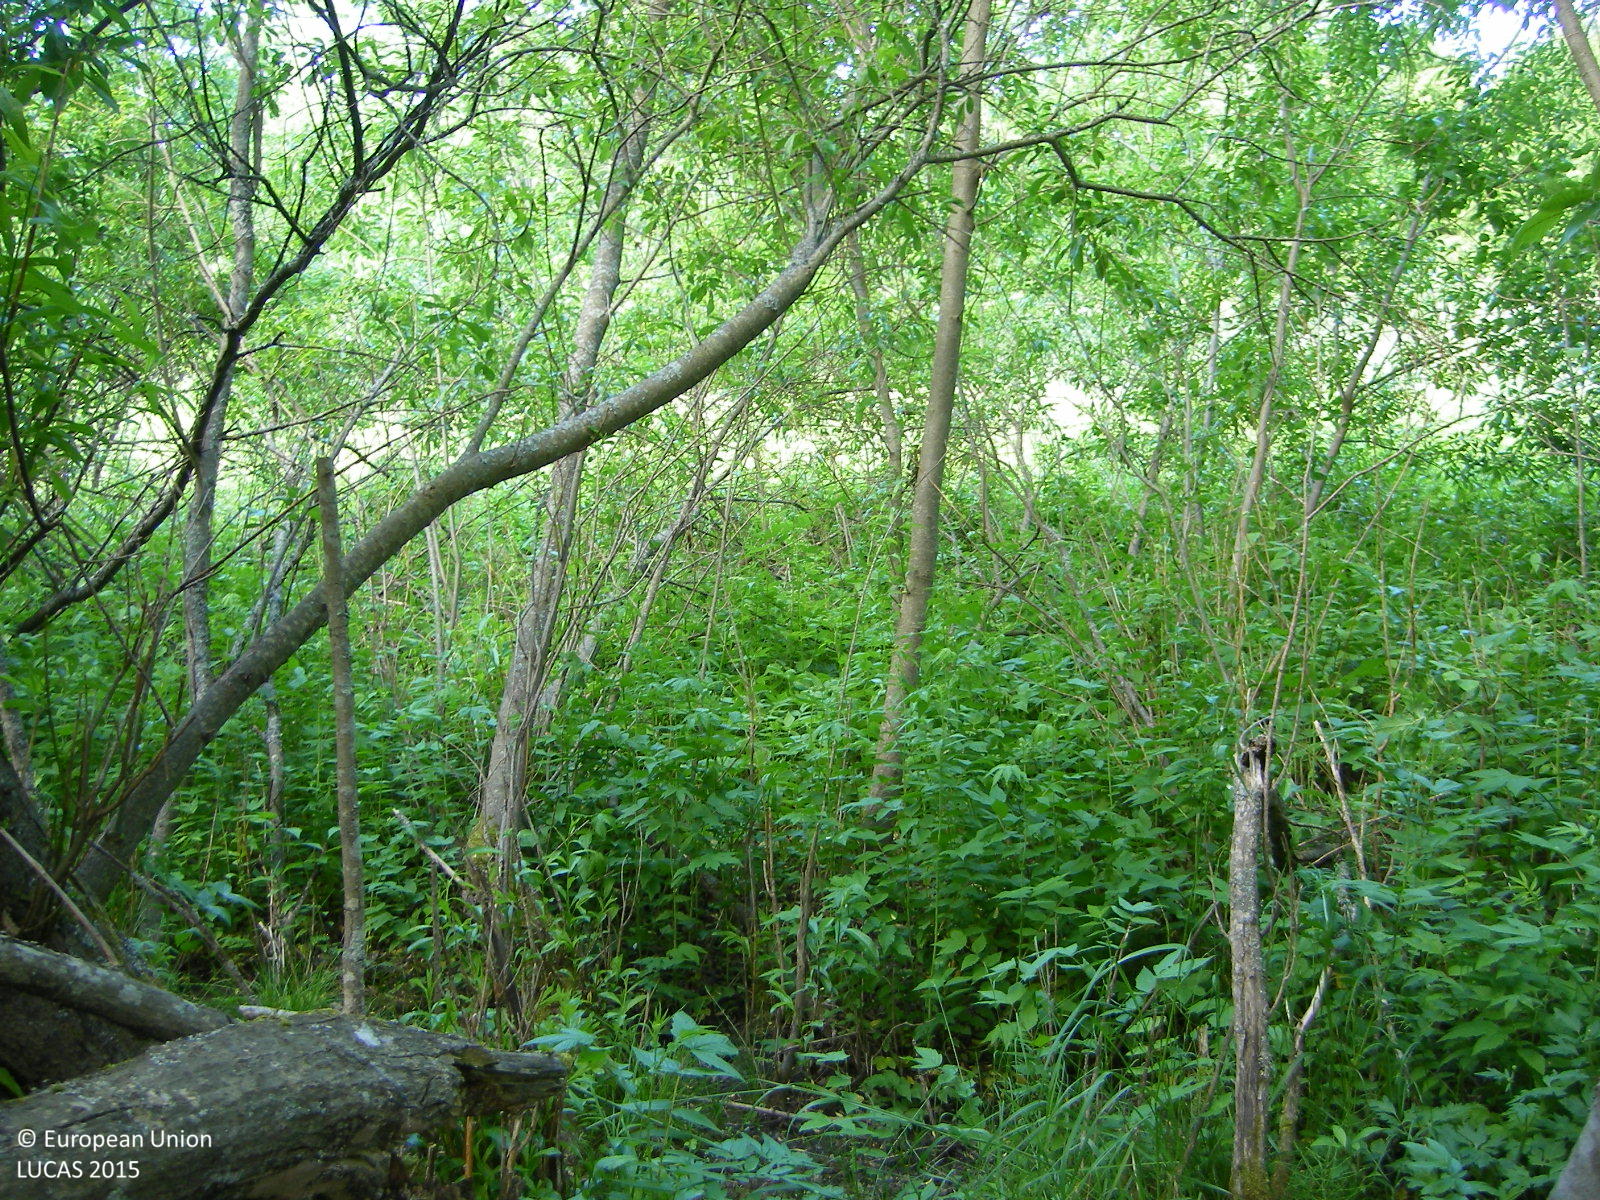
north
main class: Woodland
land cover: Broadleaved woodland
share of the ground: > 75 %
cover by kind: broadleaved forest trees 100 %
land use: Forestry
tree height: > 5 m
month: June
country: FI
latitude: 60.3821
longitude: 23.9363
